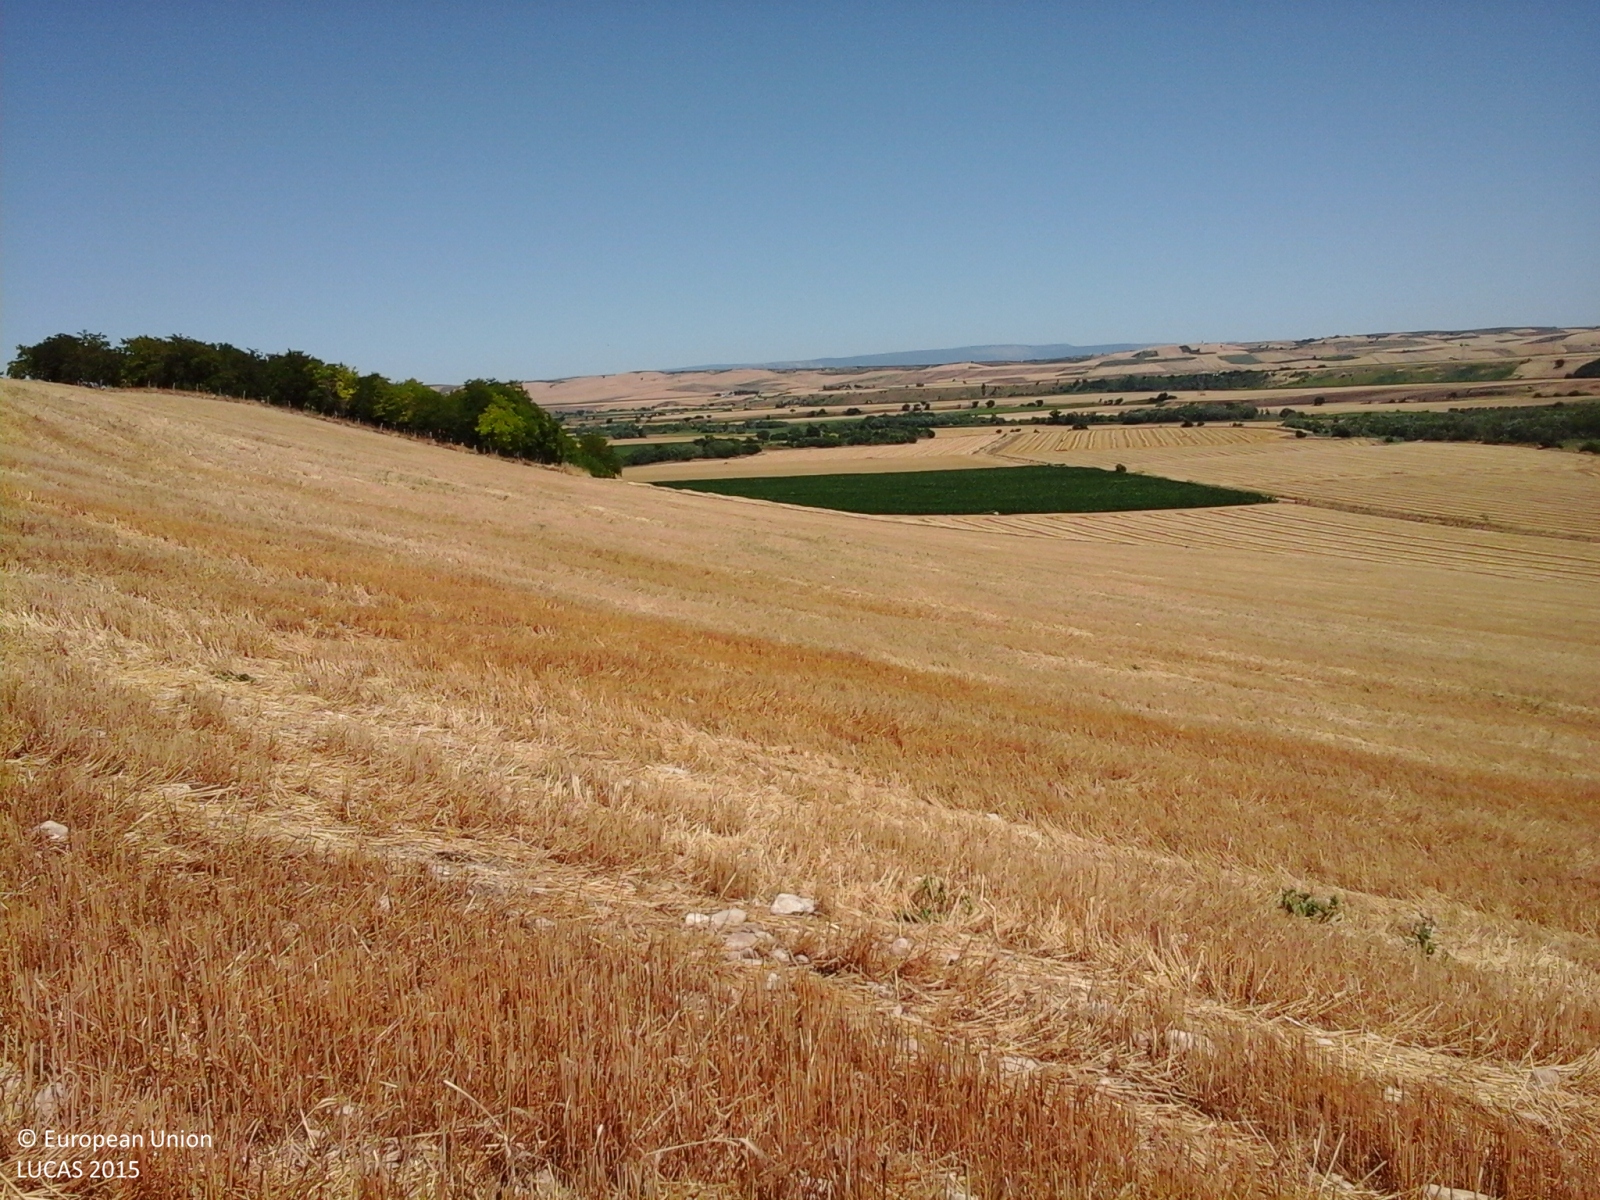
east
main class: Cropland
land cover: Durum wheat
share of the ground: > 75 %
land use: Agriculture (excluding fallow land and kitchen gardens)
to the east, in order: Durum wheat
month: June
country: IT
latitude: 41.7090
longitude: 15.1393
